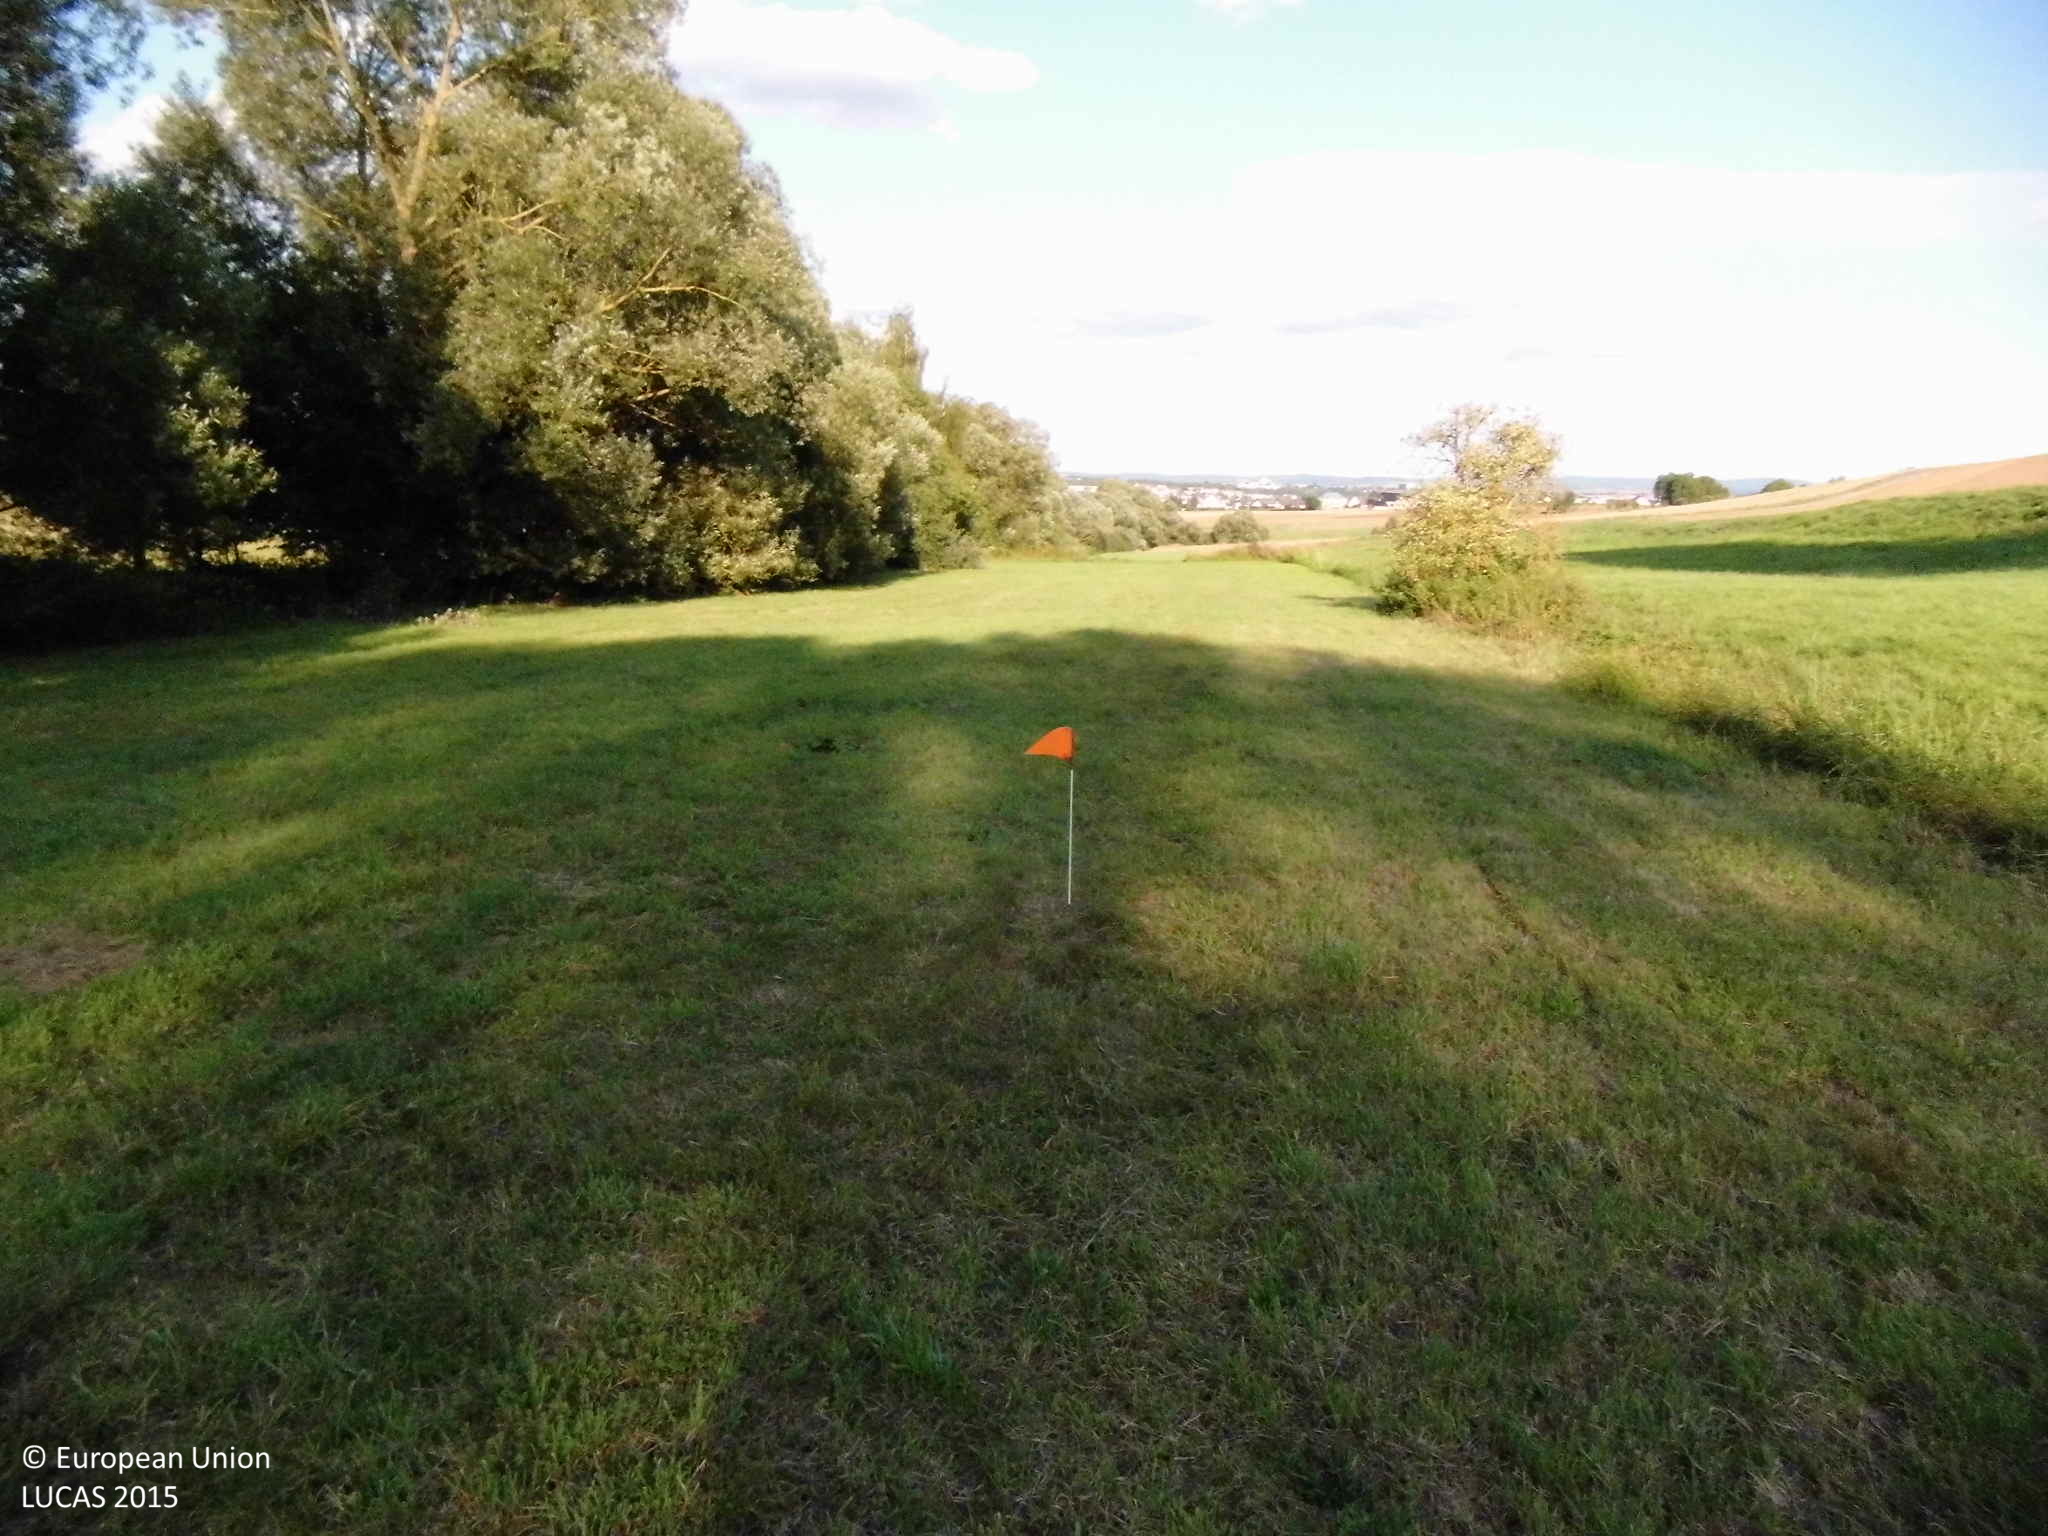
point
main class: Grassland
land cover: Grassland without tree/shrub cover
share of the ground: > 75 %
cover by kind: herbaceous plants 100 %
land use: Agriculture (excluding fallow land and kitchen gardens)
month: August
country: DE
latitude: 50.4008
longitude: 8.0167
